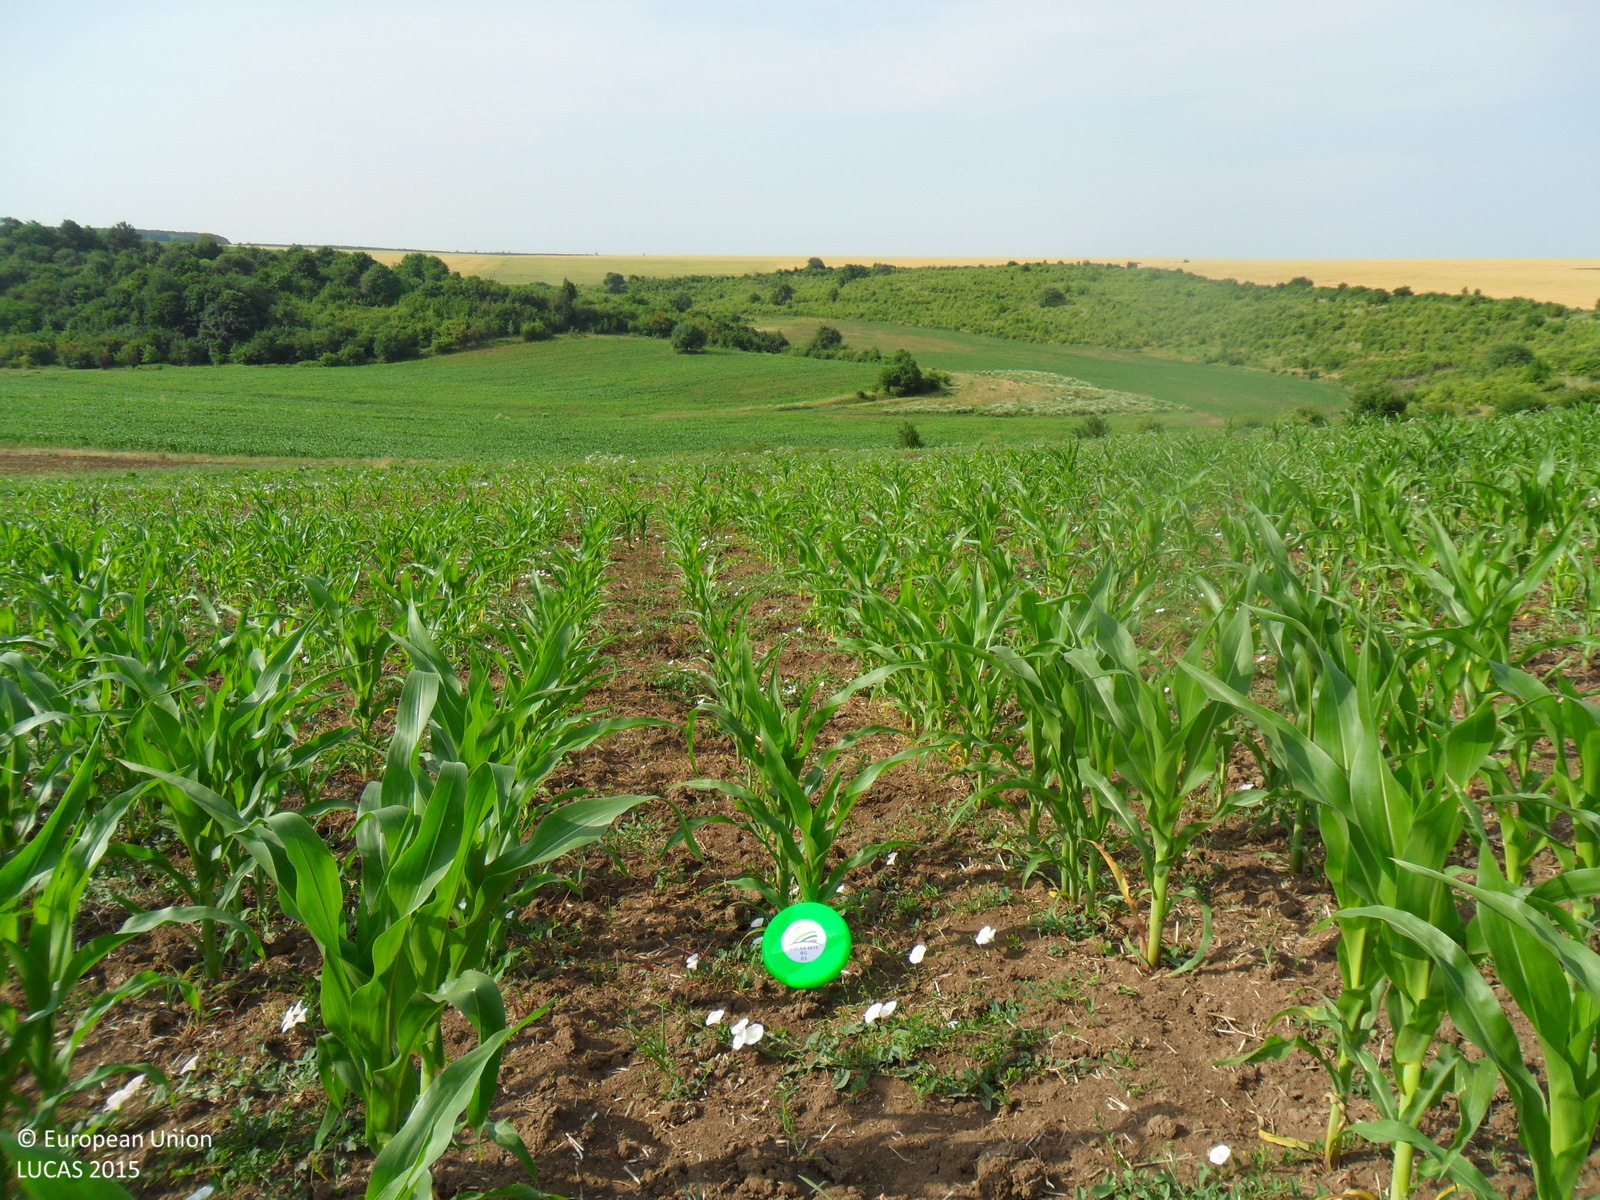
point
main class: Cropland
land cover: Maize
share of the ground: 50 - 75 %
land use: Agriculture (excluding fallow land and kitchen gardens)
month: June
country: BG
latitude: 43.6741
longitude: 26.8728
